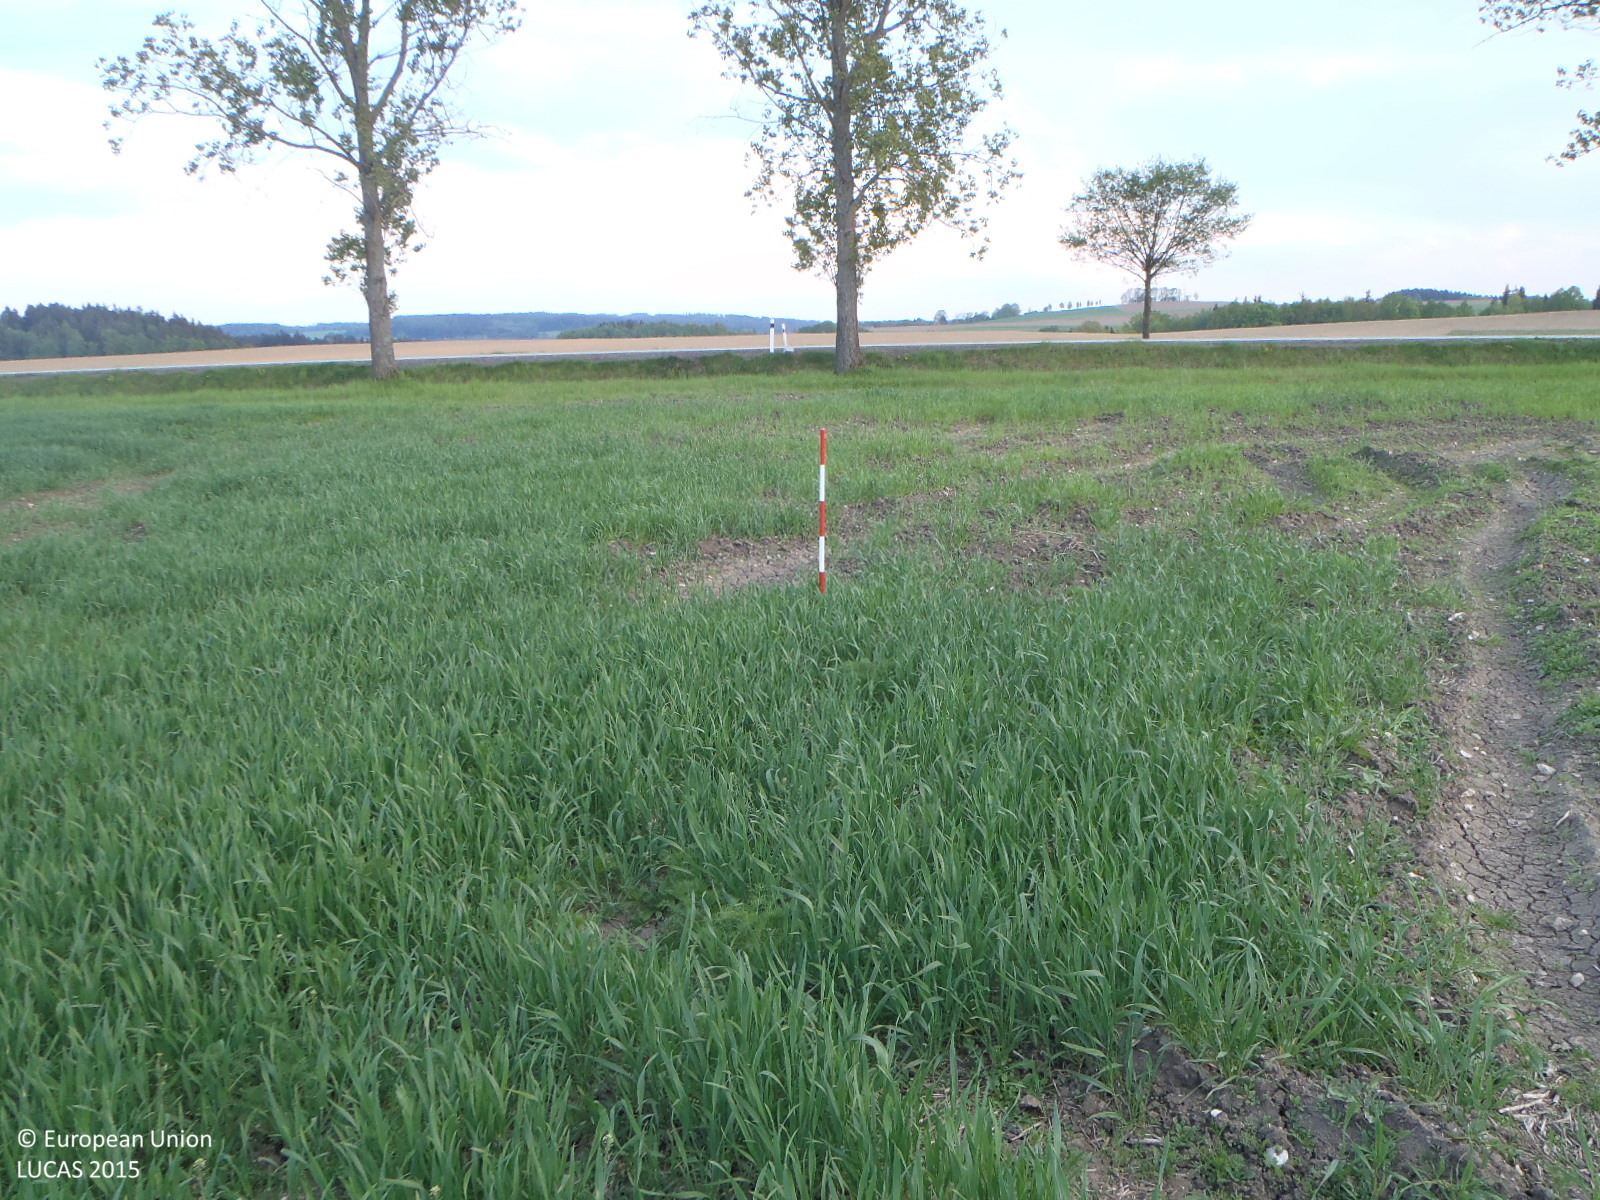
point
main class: Cropland
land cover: Triticale
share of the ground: 50 - 75 %
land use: Agriculture (excluding fallow land and kitchen gardens)
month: May
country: CZ
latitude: 49.1349
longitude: 15.0599
